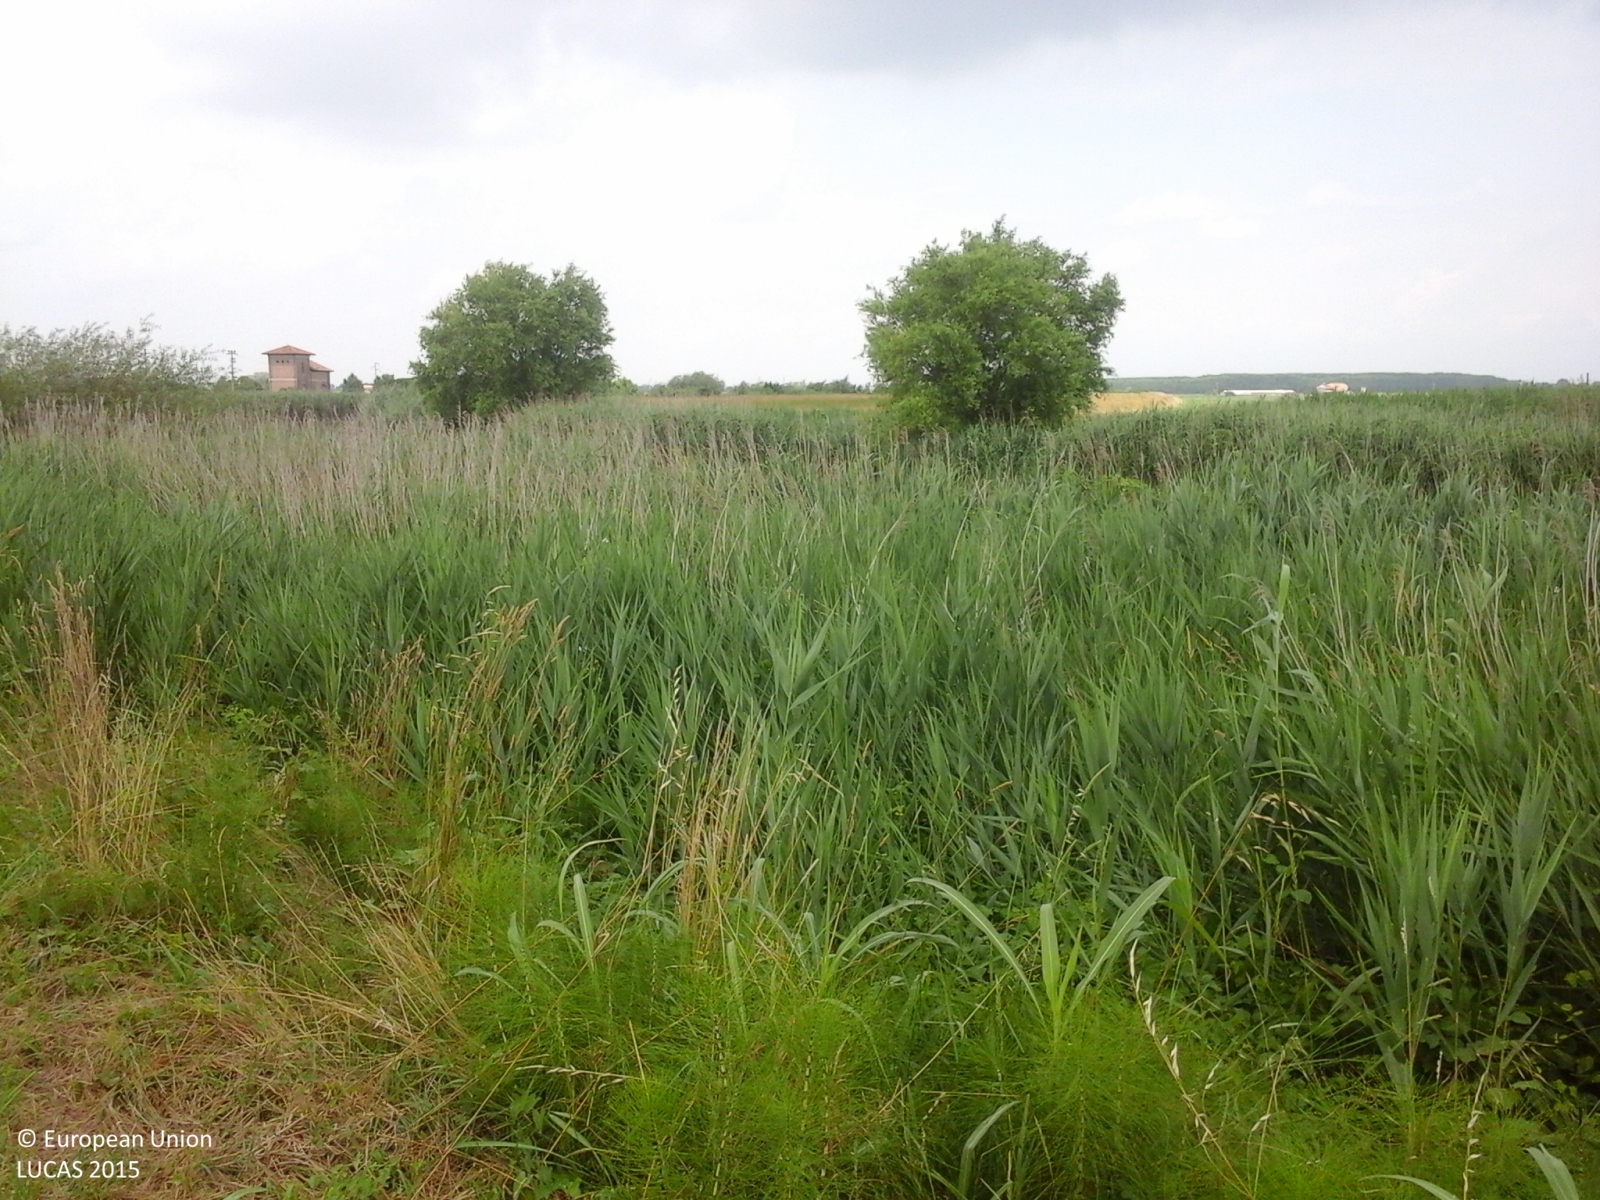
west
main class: Grassland
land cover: Grassland without tree/shrub cover
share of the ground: > 75 %
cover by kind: herbaceous plants 100 %
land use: Protection infrastructures
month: June
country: IT
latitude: 45.7208
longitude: 12.7586
